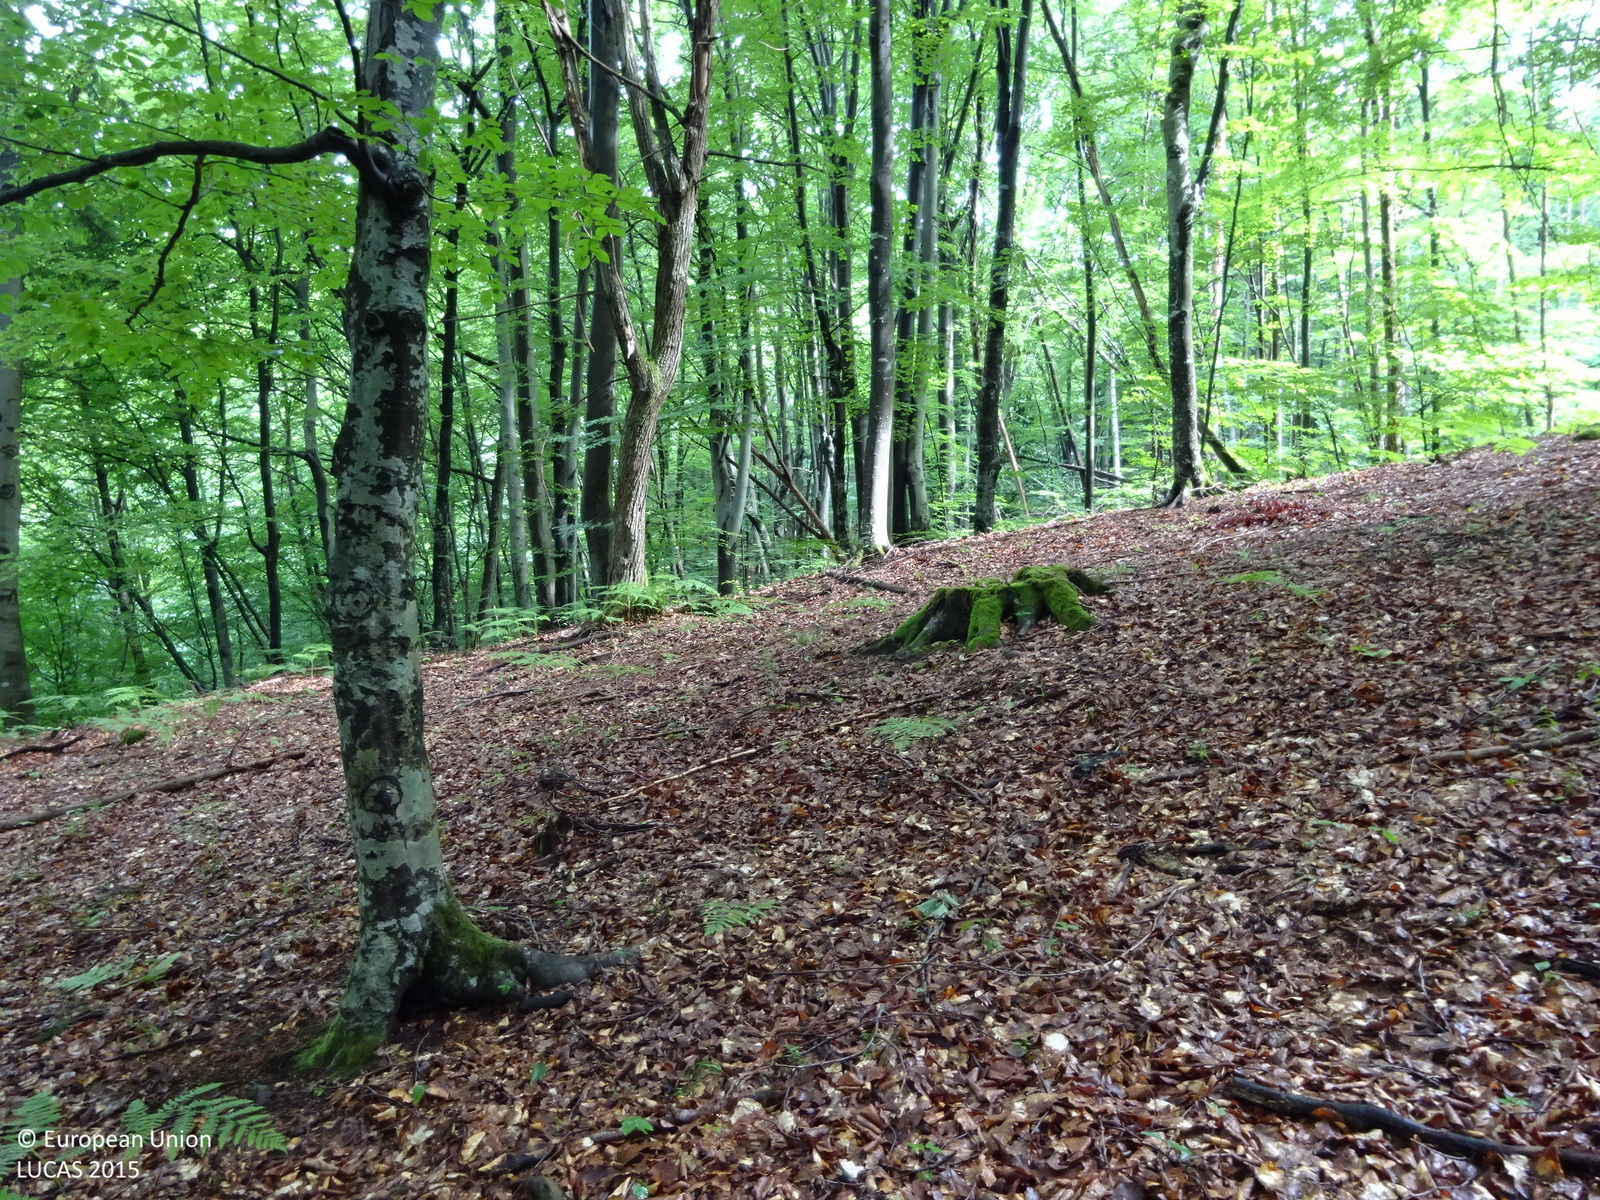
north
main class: Woodland
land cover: Broadleaved woodland
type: mountainous beech forest
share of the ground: > 75 %
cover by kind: broadleaved forest trees 90 %, unconsolidated bare surface 10 %
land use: Forestry
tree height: > 5 m
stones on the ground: < 10 %
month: June
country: AT
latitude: 46.7008
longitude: 15.4266
